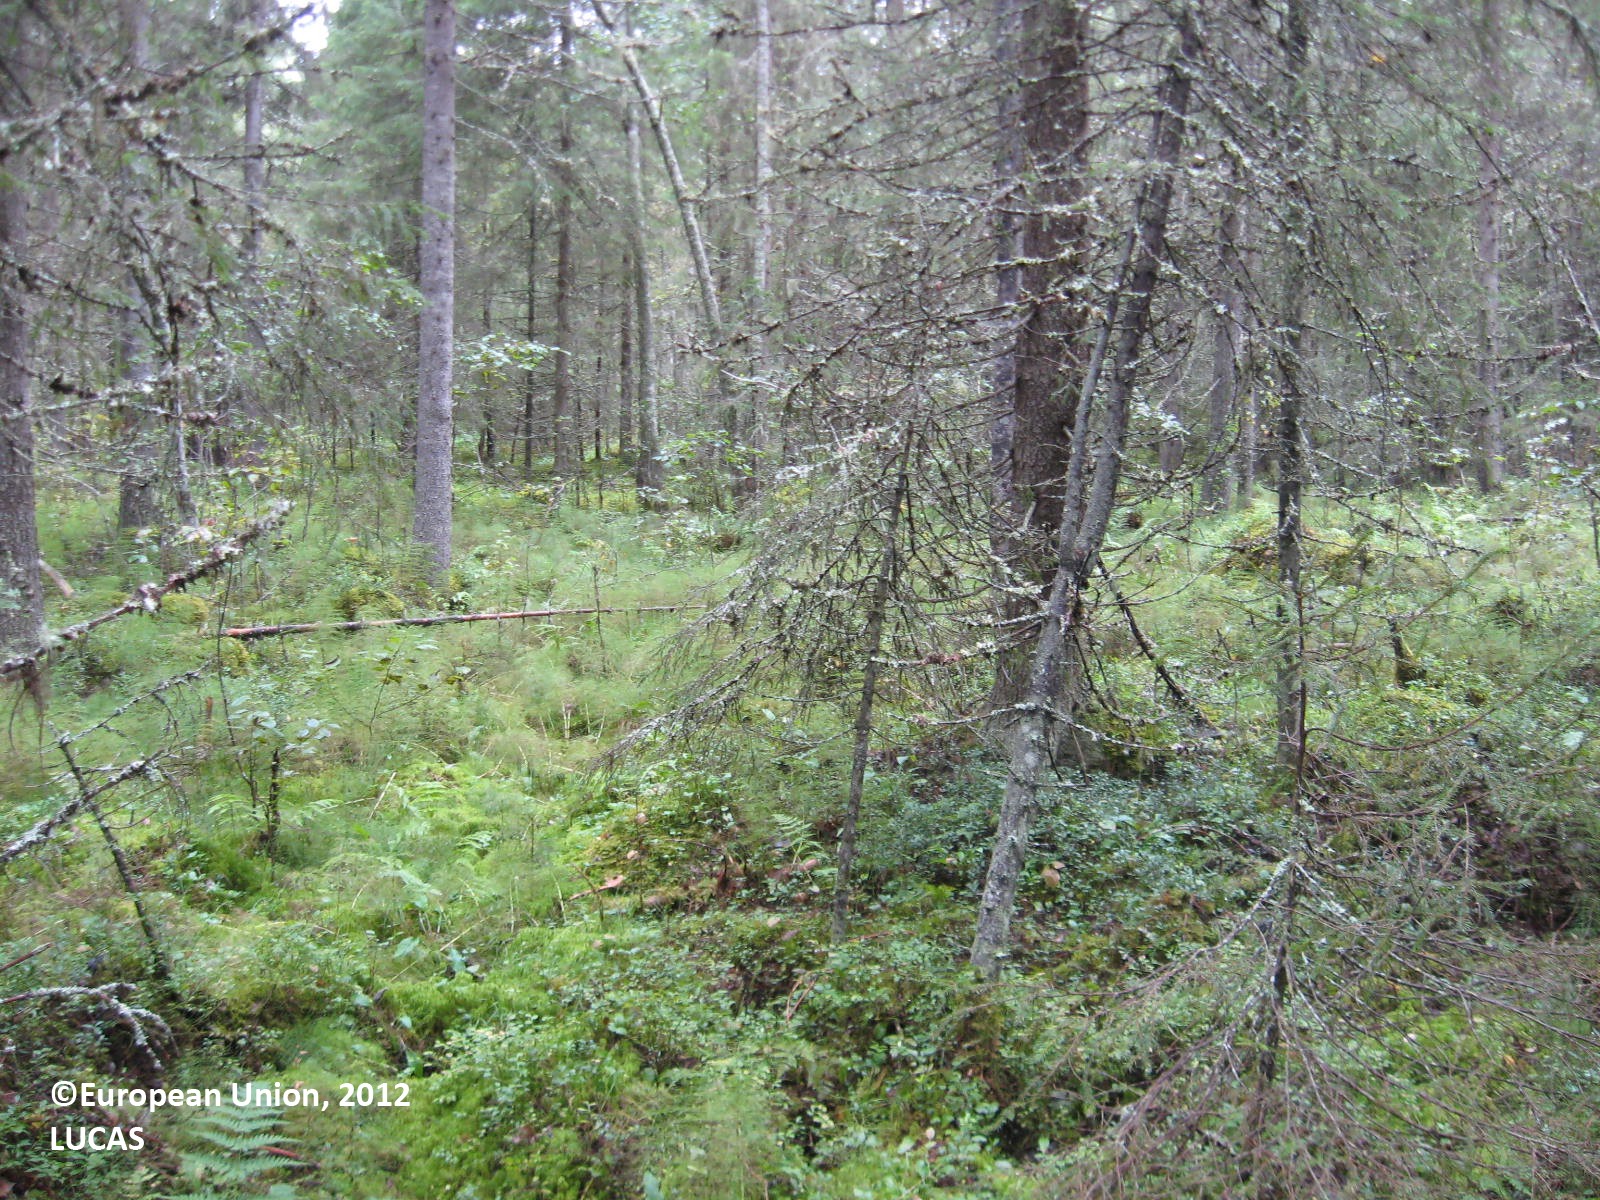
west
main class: Woodland
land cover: Spruce dominated coniferous woodland
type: boreal forest
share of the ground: > 75 %
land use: Forestry
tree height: > 5 m
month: August
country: FI
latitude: 63.4833
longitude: 29.5214
